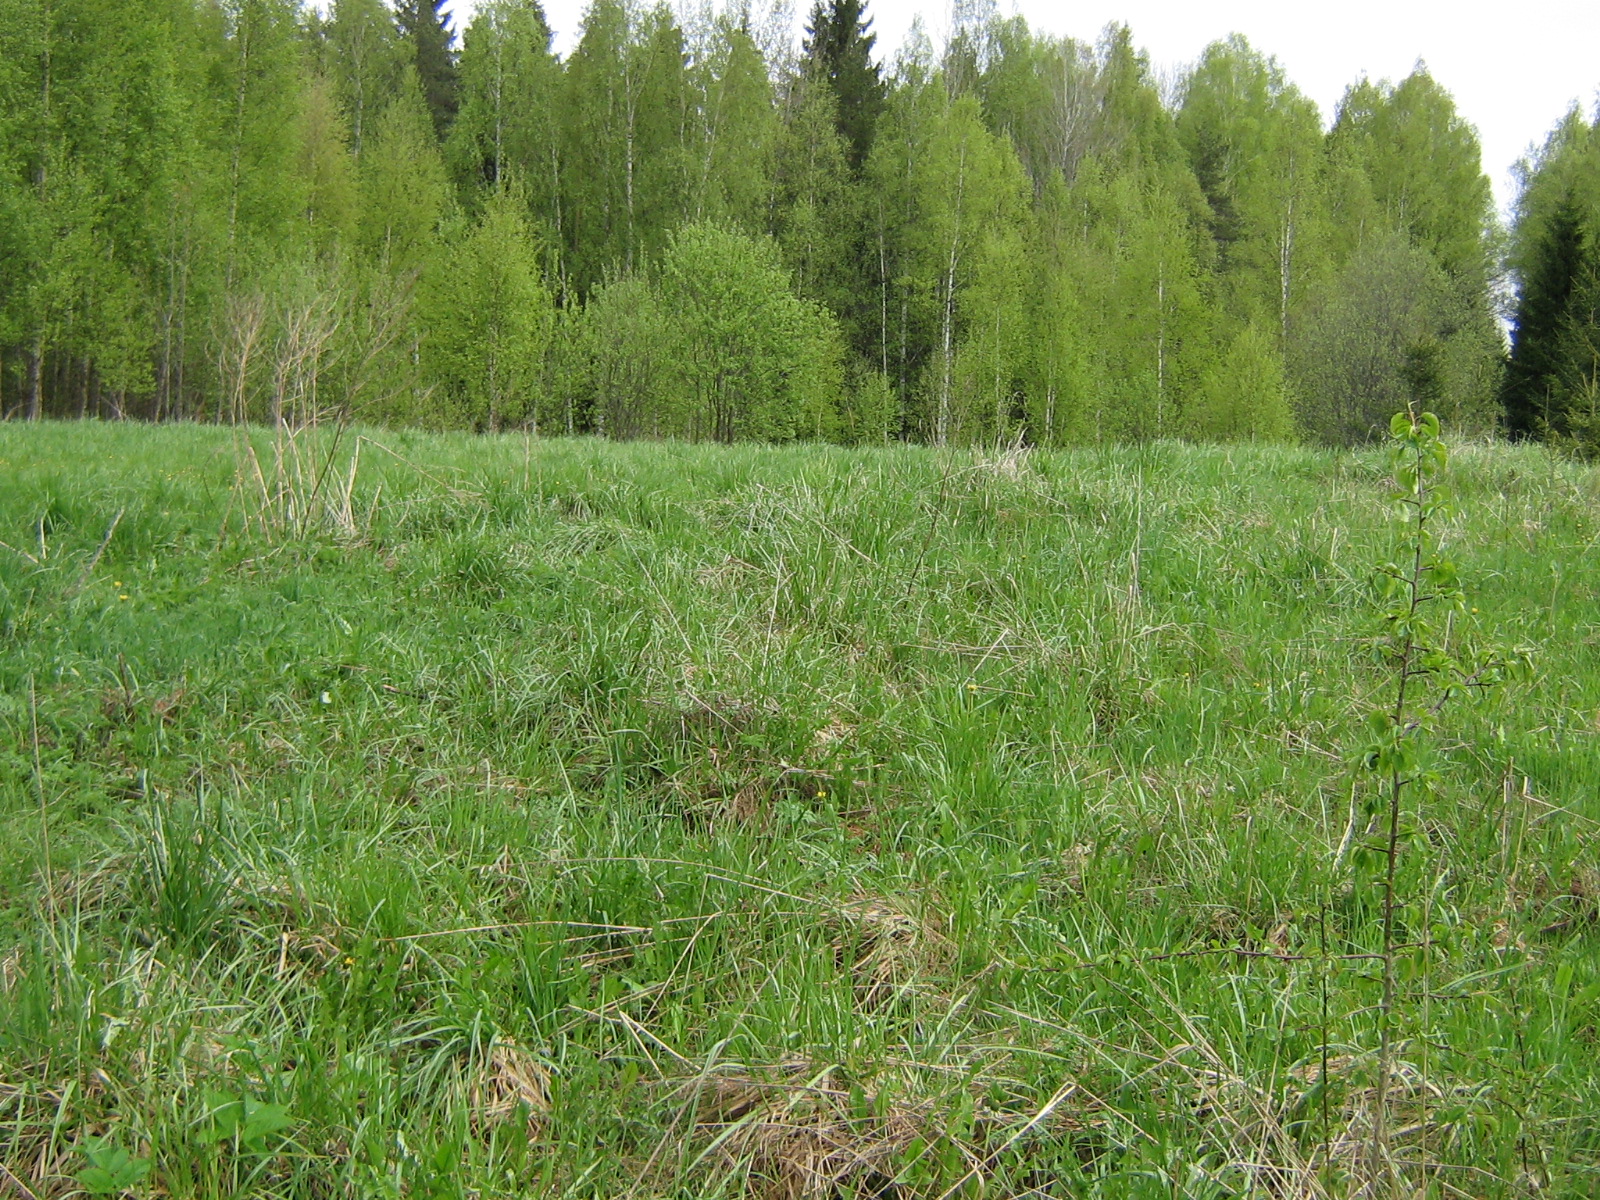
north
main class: Grassland
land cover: Grassland without tree/shrub cover
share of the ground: > 75 %
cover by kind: herbaceous plants 100 %
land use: Abandoned areas
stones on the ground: < 10 %
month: May
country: LV
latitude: 57.2102
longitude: 25.4293
